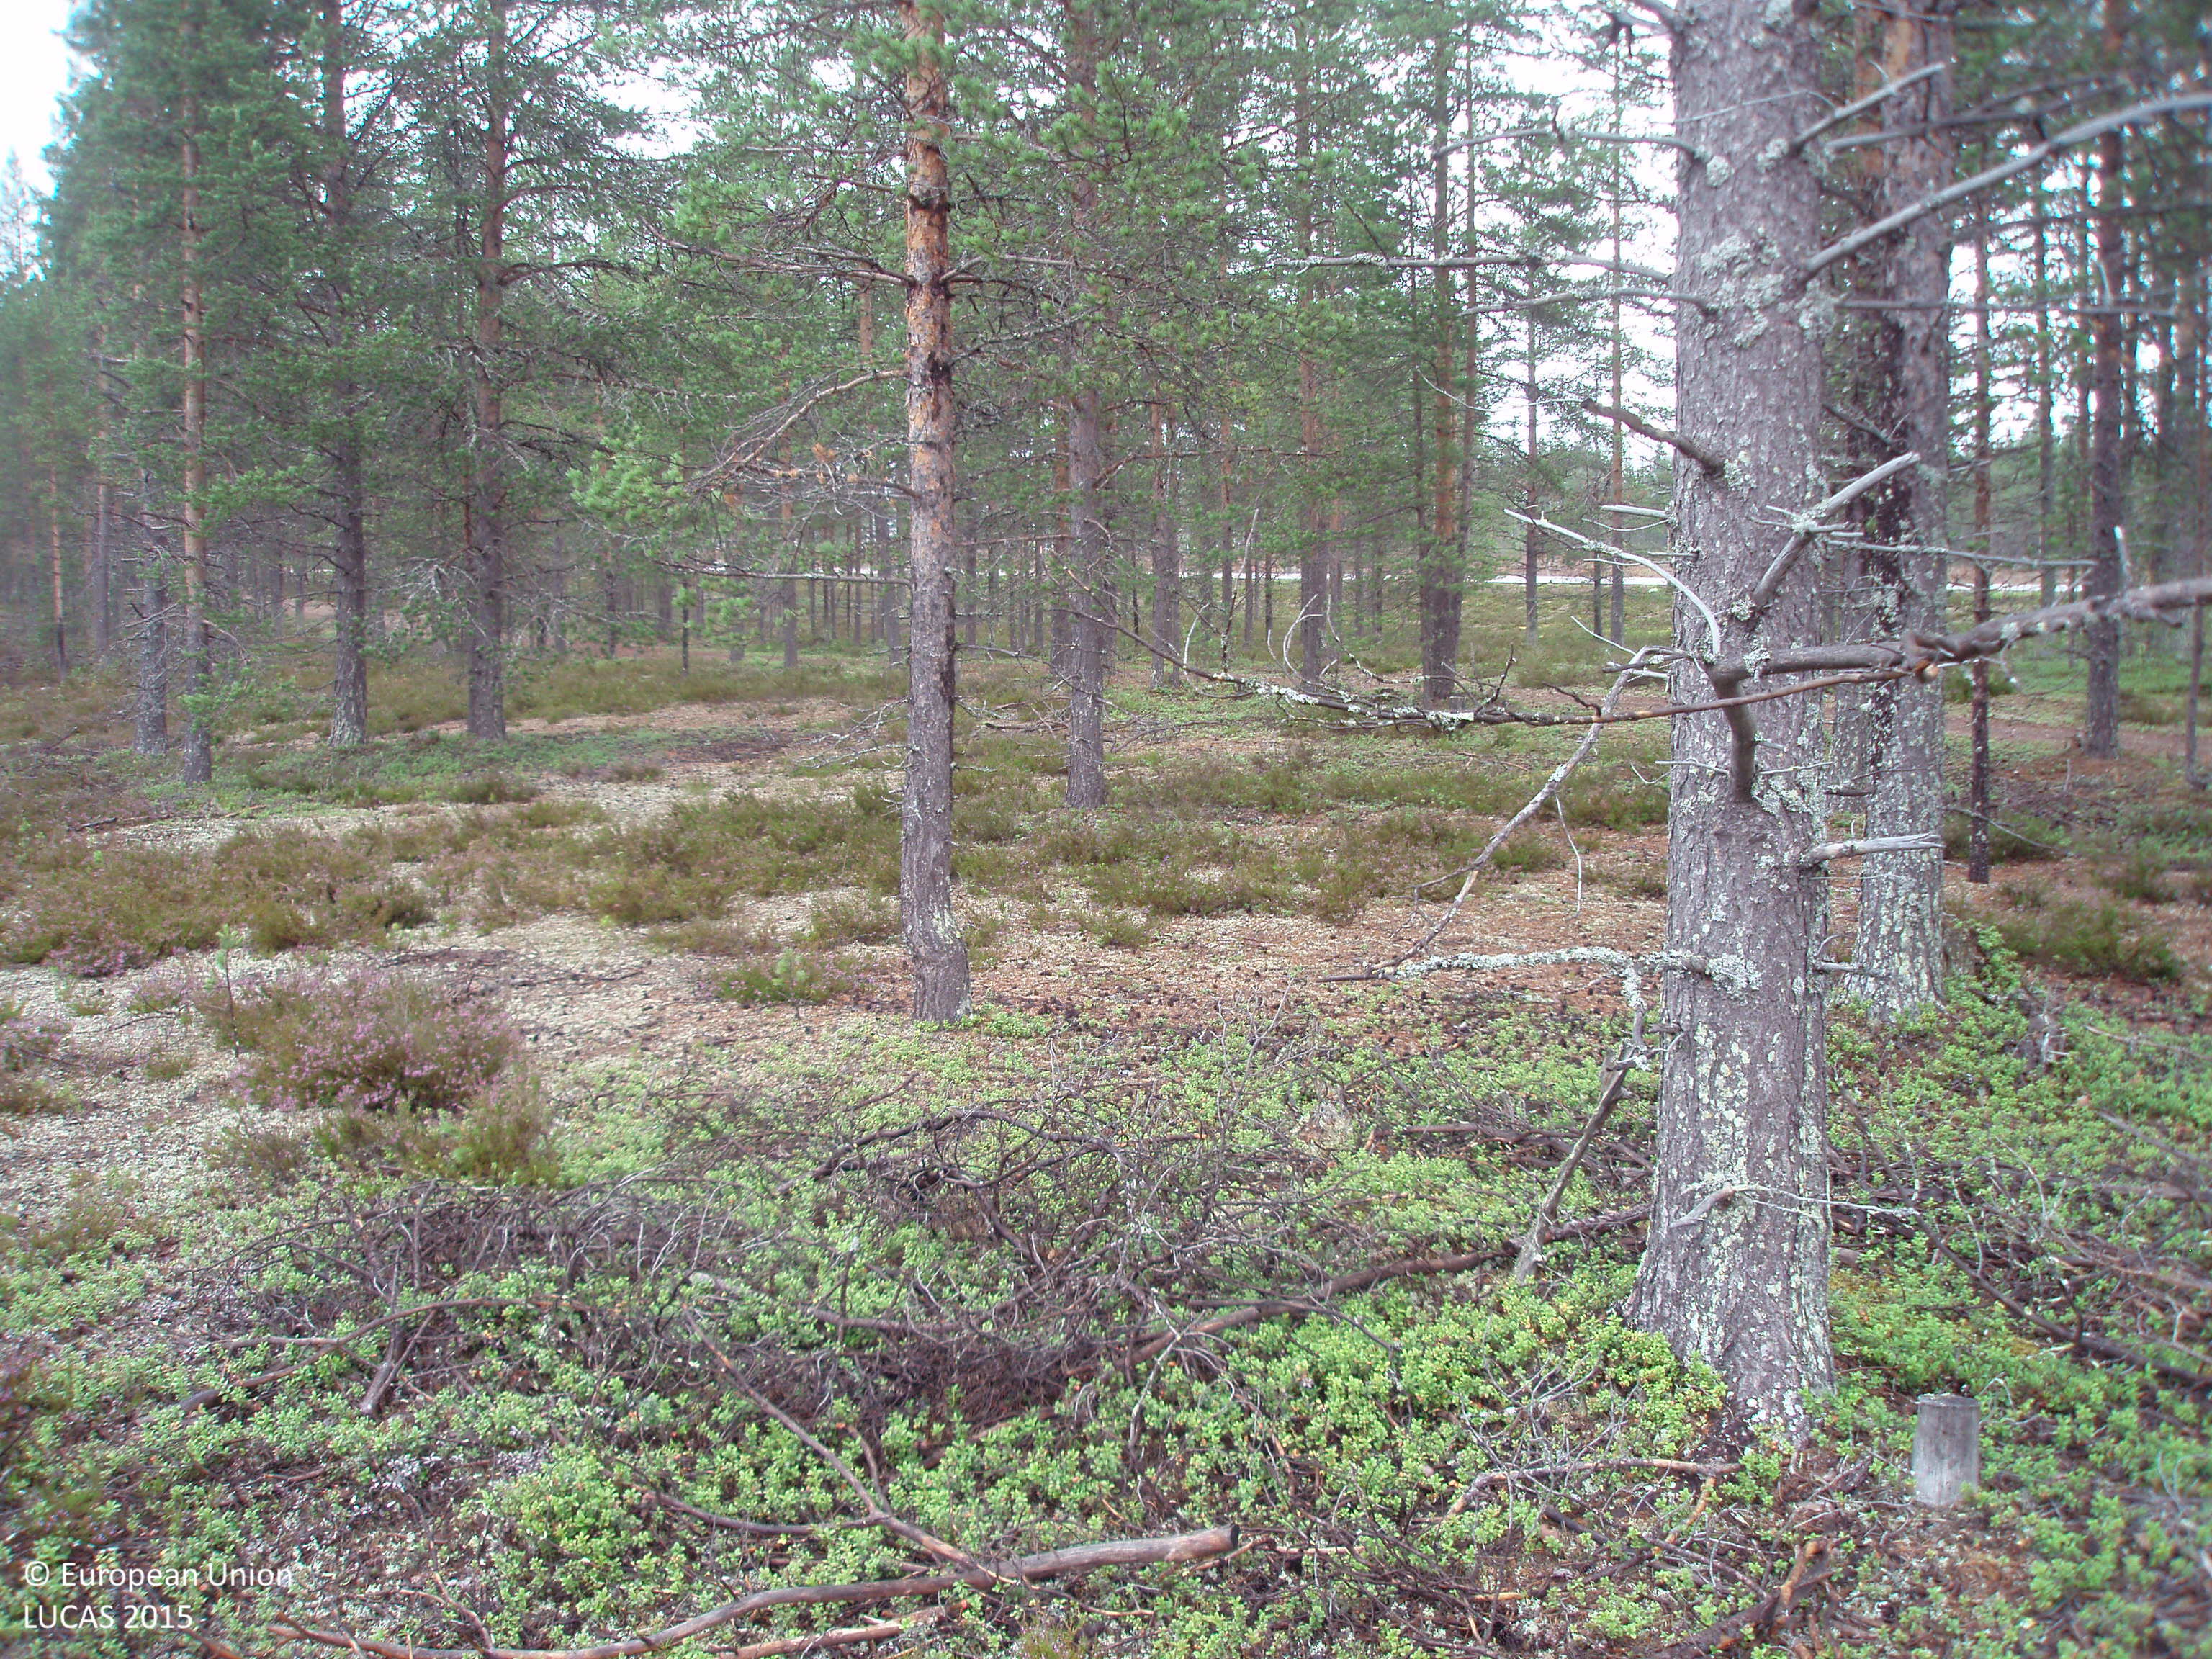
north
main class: Woodland
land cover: Pine dominated coniferous woodland
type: boreal forest
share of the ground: > 75 %
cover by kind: coniferous forest trees 75 %, shrubs 25 %
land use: Forestry
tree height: > 5 m
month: August
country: FI
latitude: 65.6625
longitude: 27.3679
